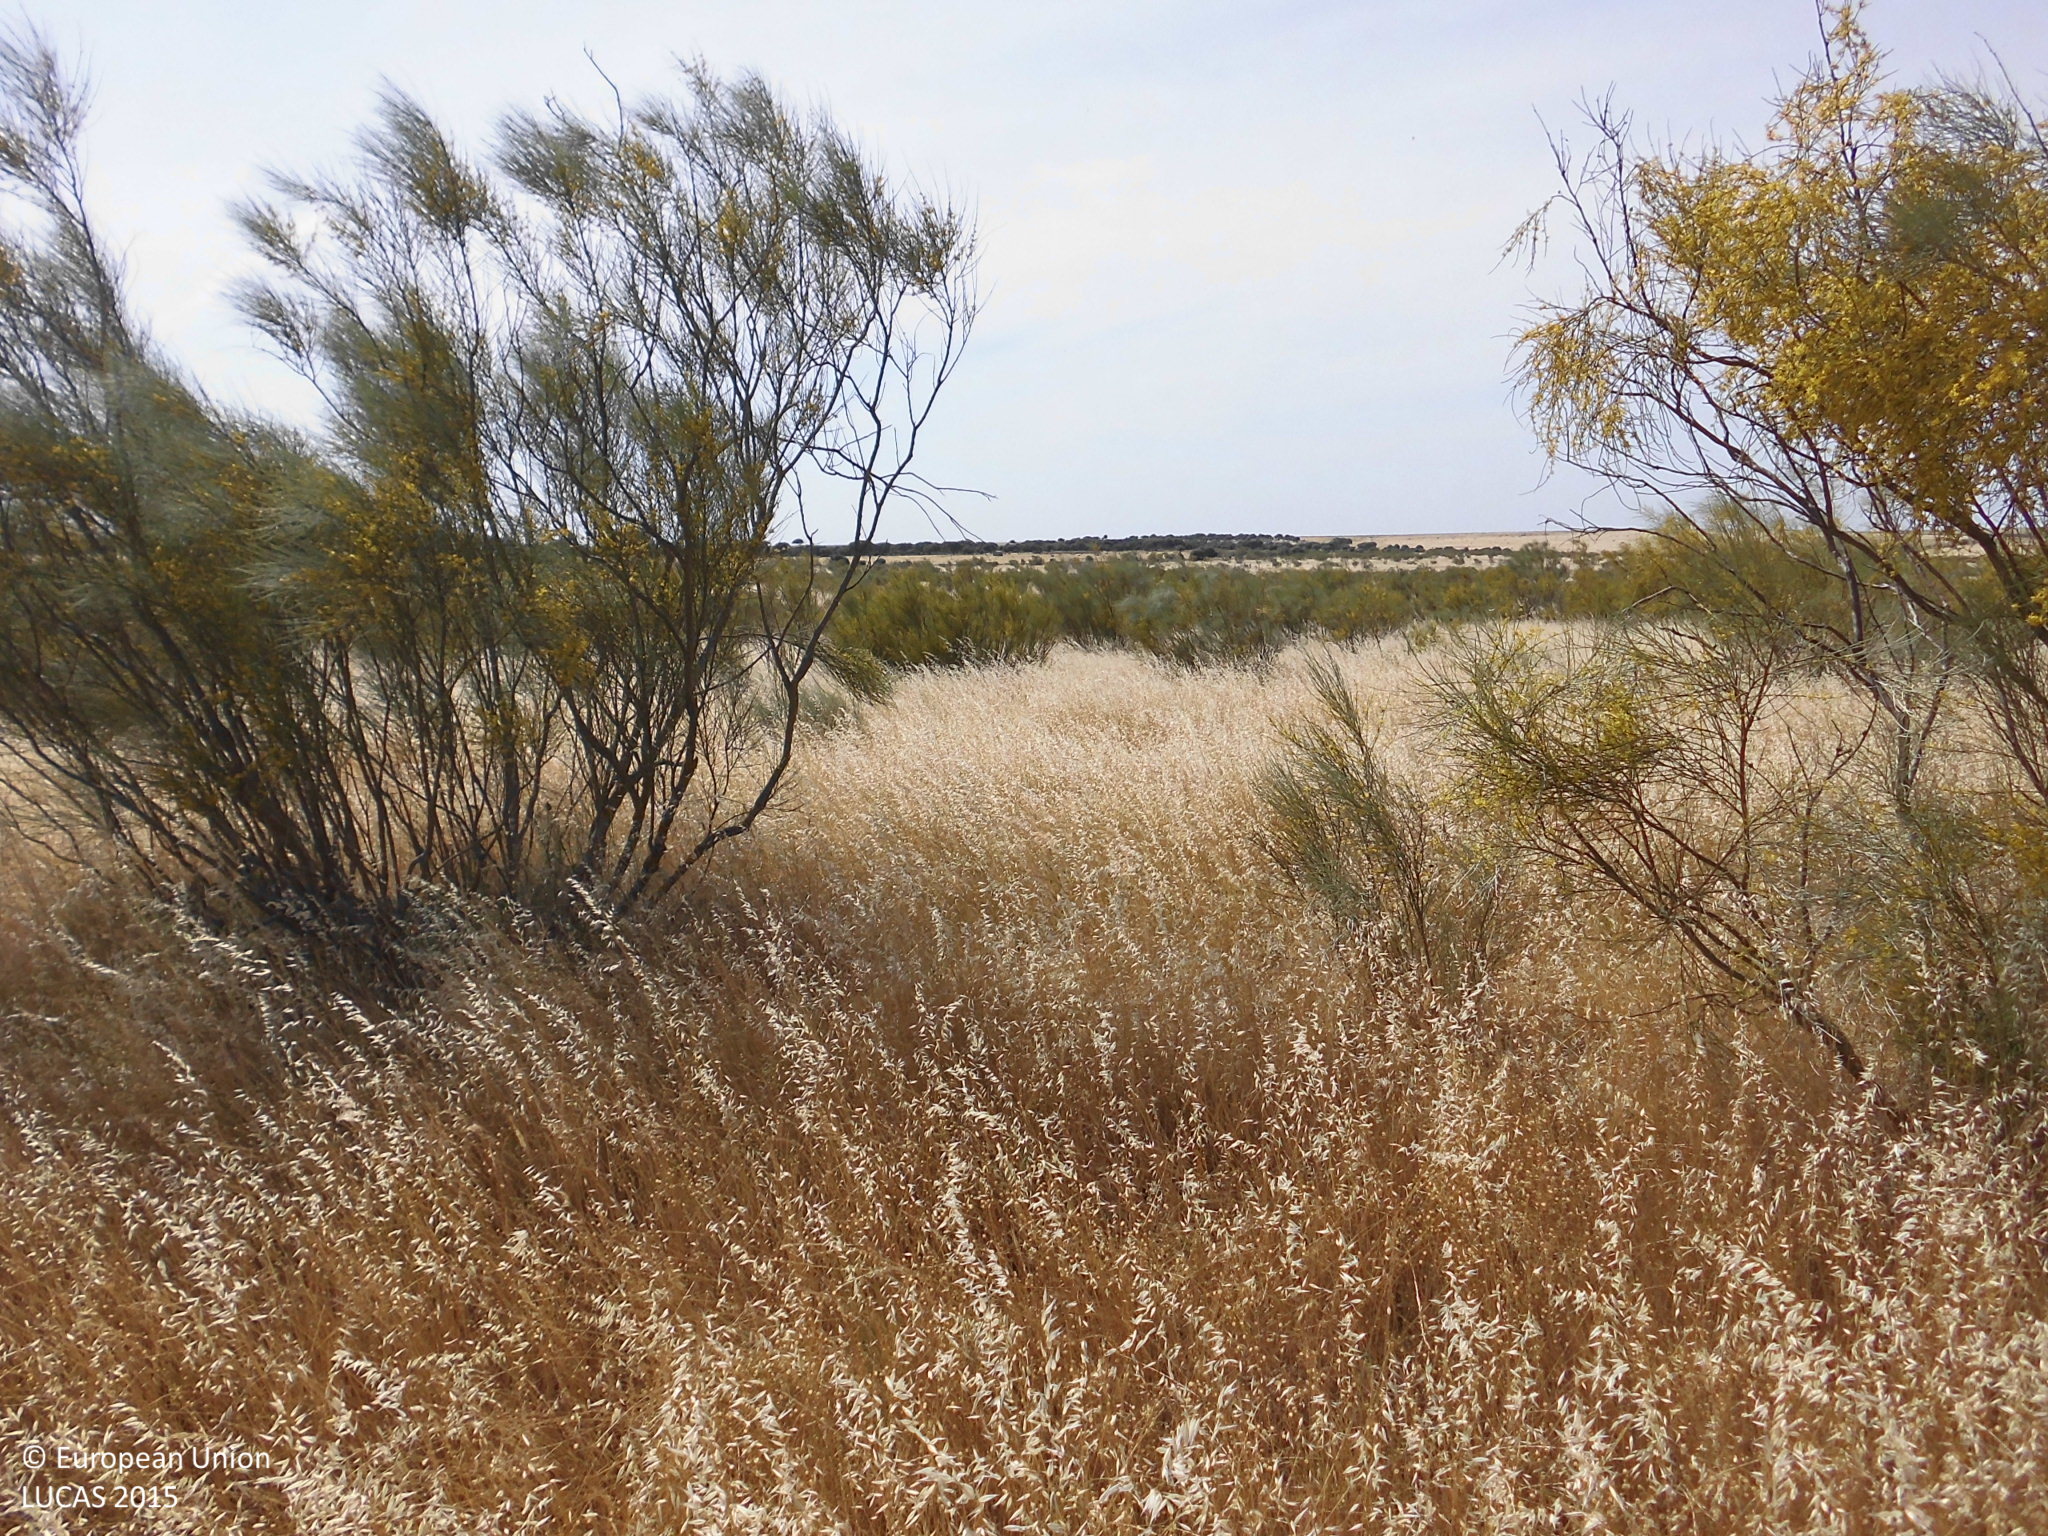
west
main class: Shrubland
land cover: Shrubland without tree cover
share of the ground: 10 - 25 %
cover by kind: herbaceous plants 85 %, shrubs 15 %
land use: Semi-natural and natural areas not in use
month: May
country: ES
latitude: 39.4608
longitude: -5.9947
